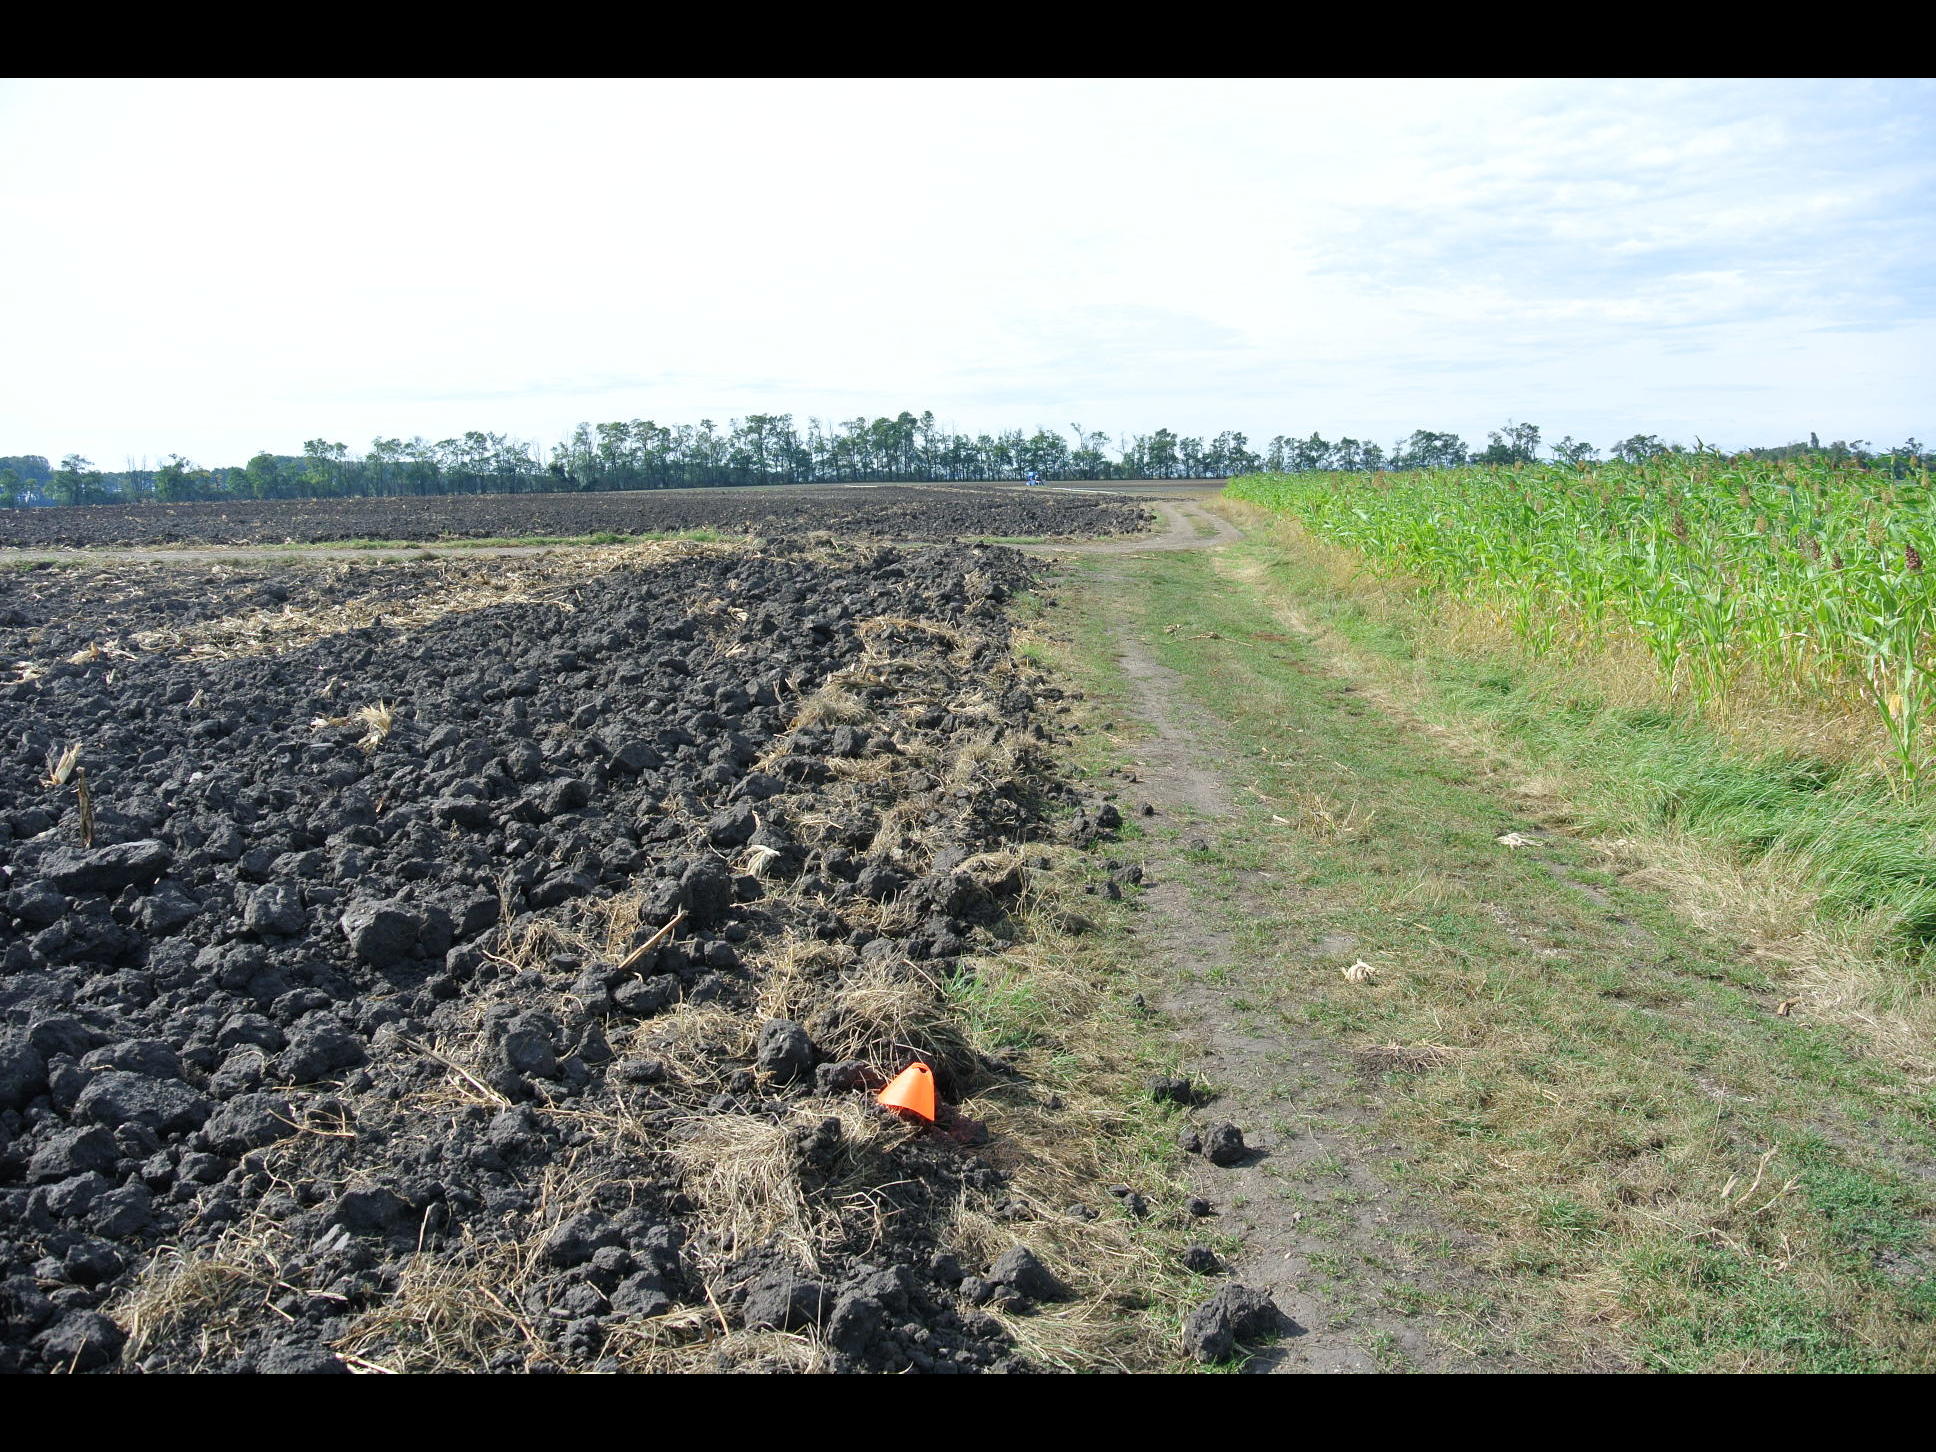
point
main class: Cropland
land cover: Maize
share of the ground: > 75 %
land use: Agriculture (excluding fallow land and kitchen gardens)
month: July
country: AT
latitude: 47.7918
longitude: 16.8808
